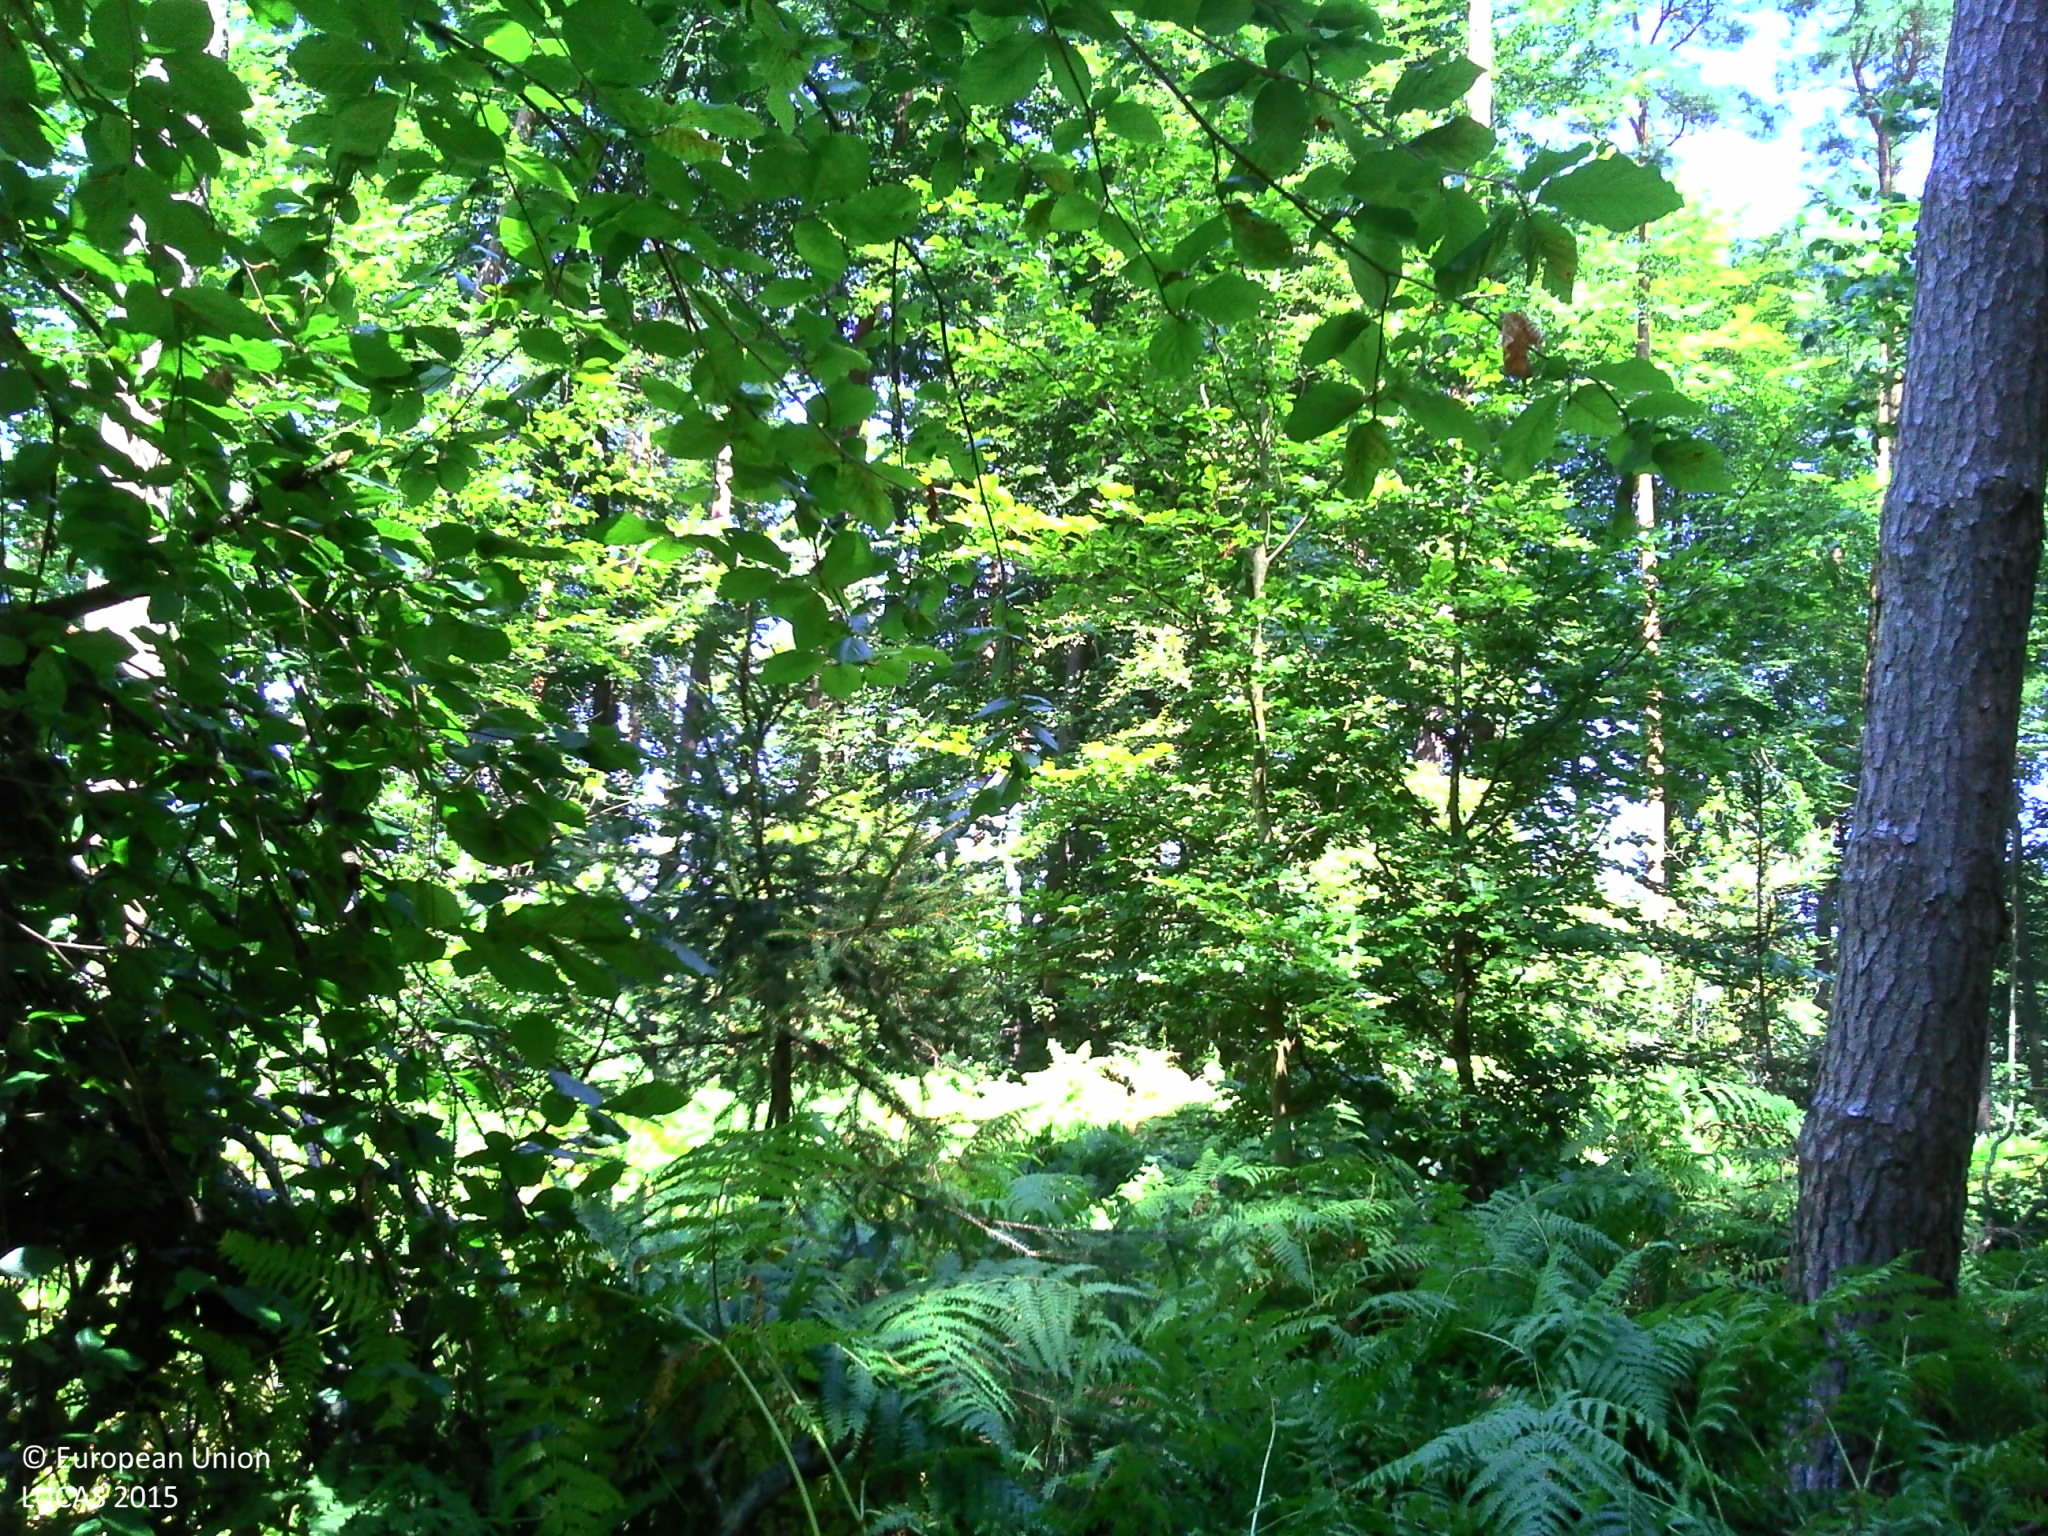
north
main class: Woodland
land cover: Pine dominated mixed woodland
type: hemiboreal forest and nemoral coniferous forest and mixed broadleaved-coniferous forest
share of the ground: > 75 %
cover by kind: broadleaved forest trees 50 %, coniferous forest trees 35 %, herbaceous plants 15 %
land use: Forestry
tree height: > 5 m
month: August
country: FR
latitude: 48.8897
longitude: 8.0231
